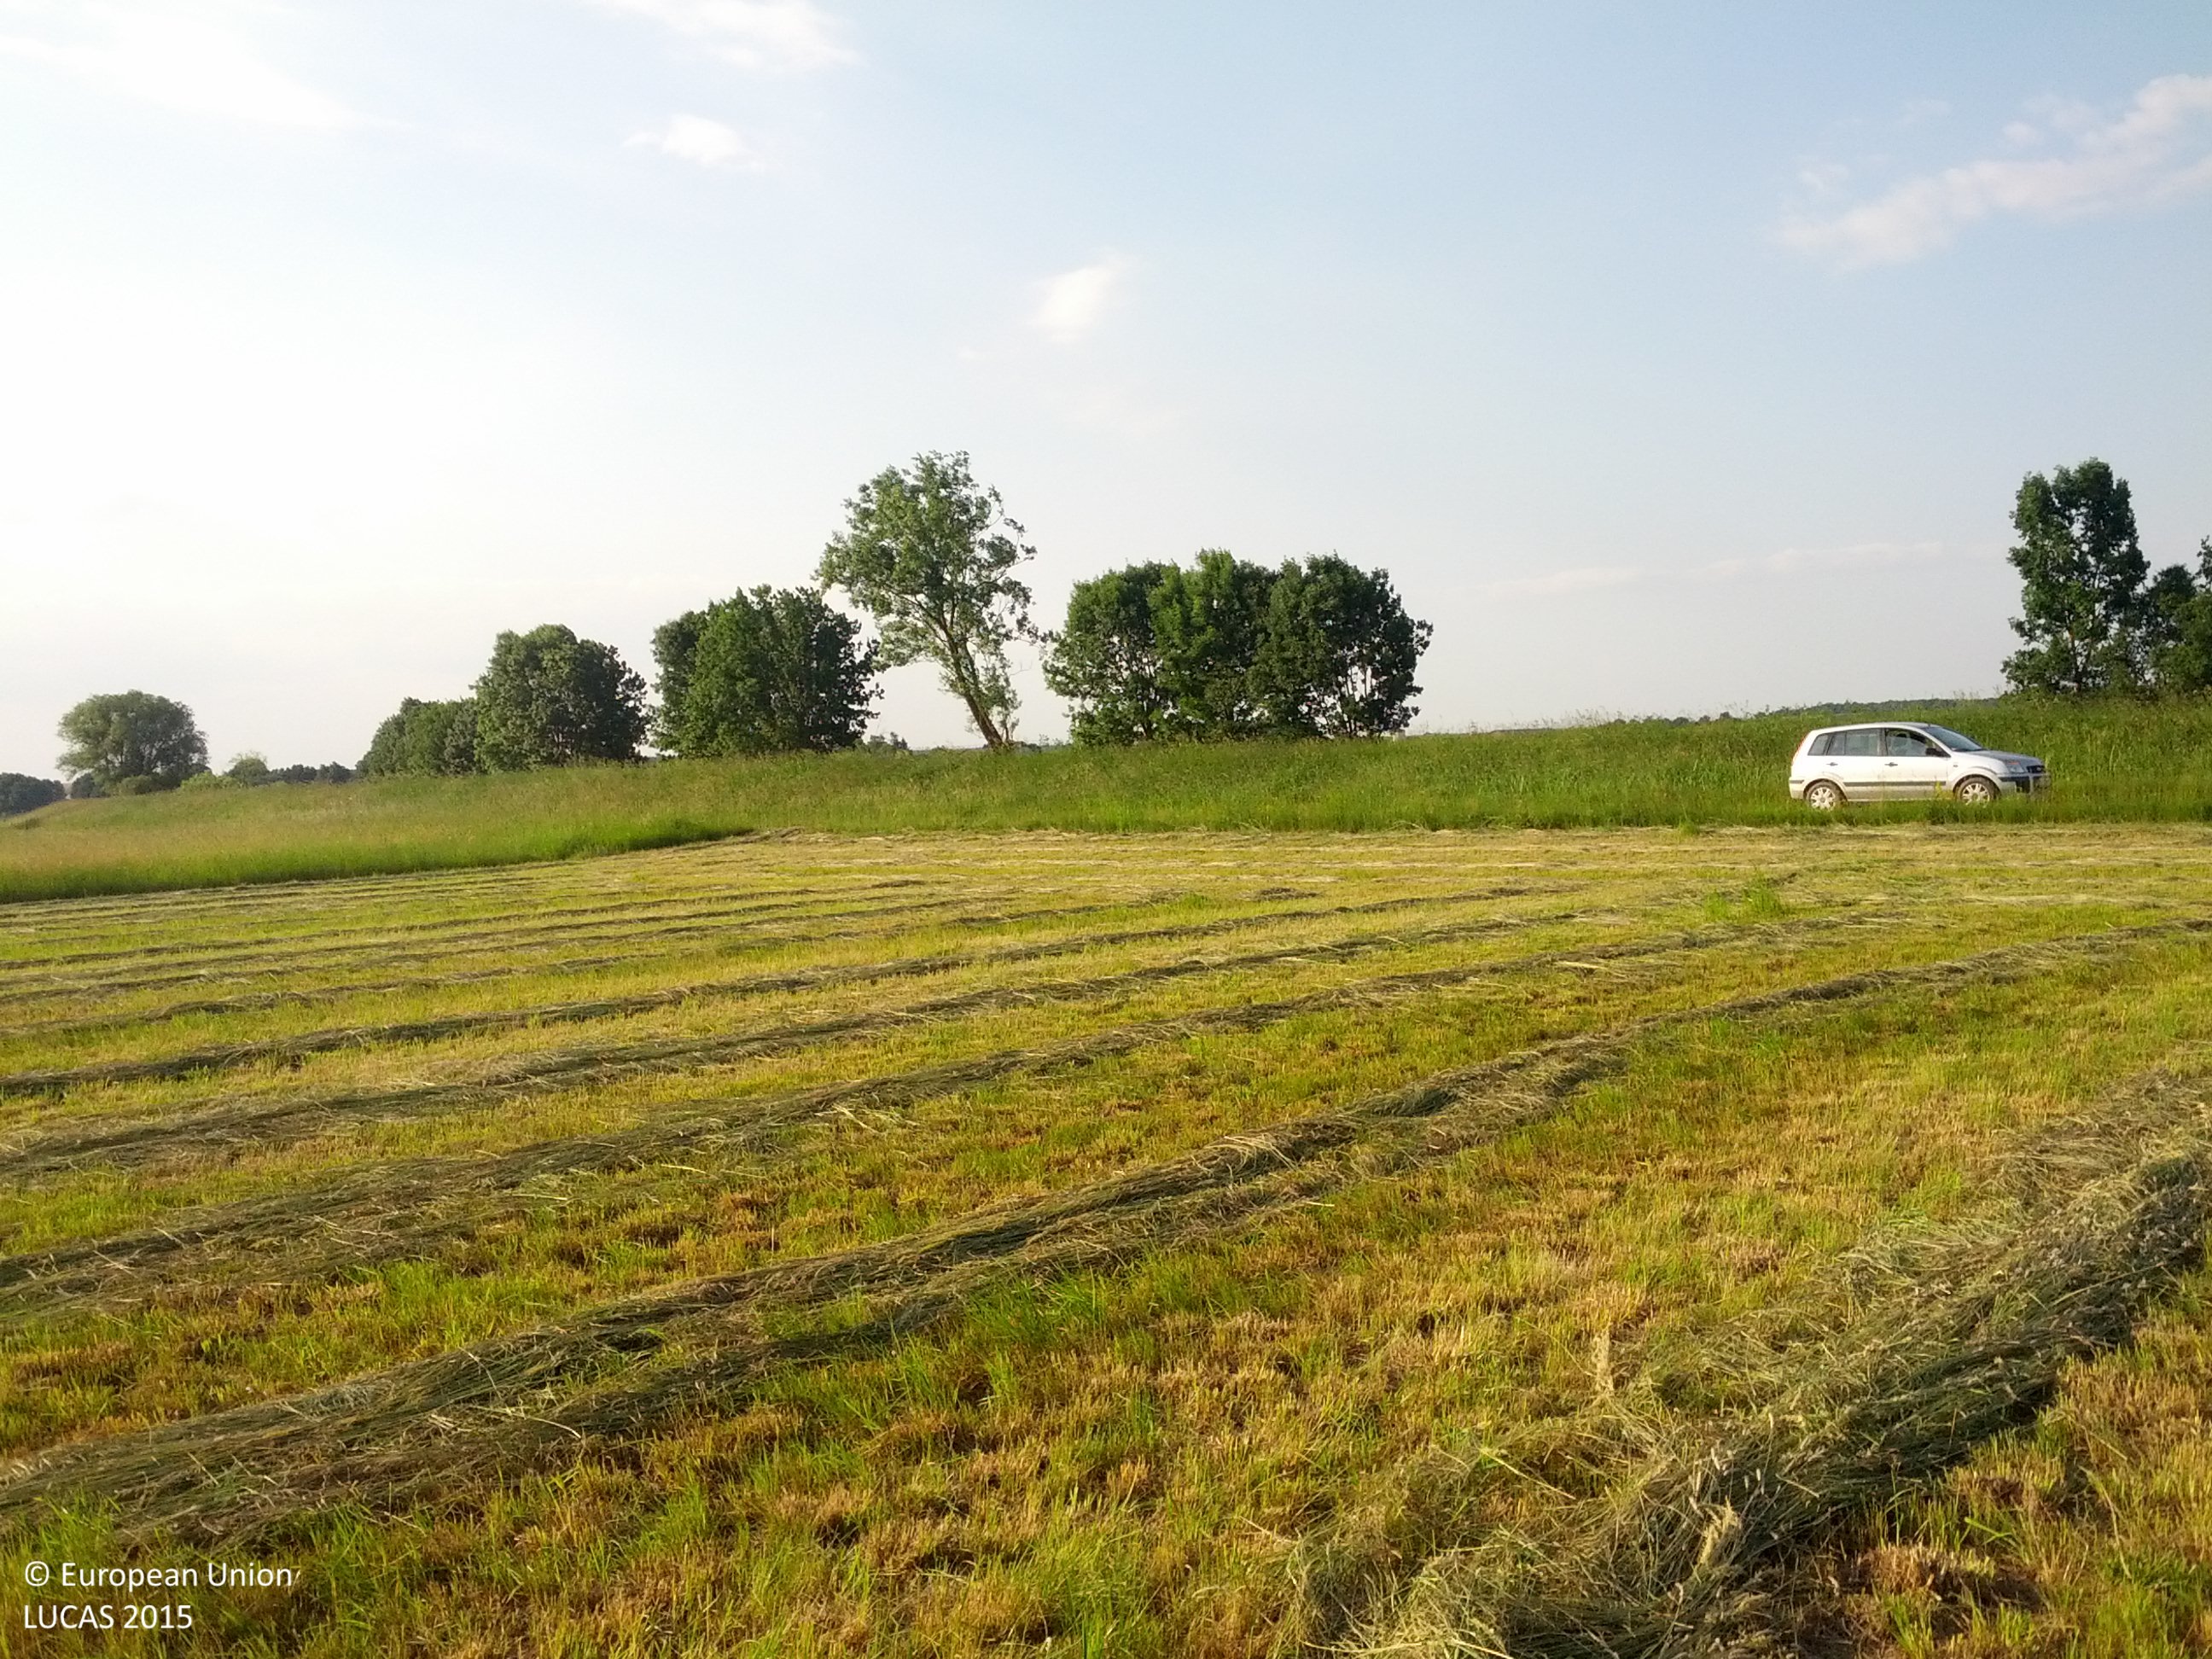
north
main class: Grassland
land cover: Grassland without tree/shrub cover
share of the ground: > 75 %
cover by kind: herbaceous plants 100 %
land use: Agriculture (excluding fallow land and kitchen gardens)
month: June
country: AT
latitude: 47.0049
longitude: 16.4602
